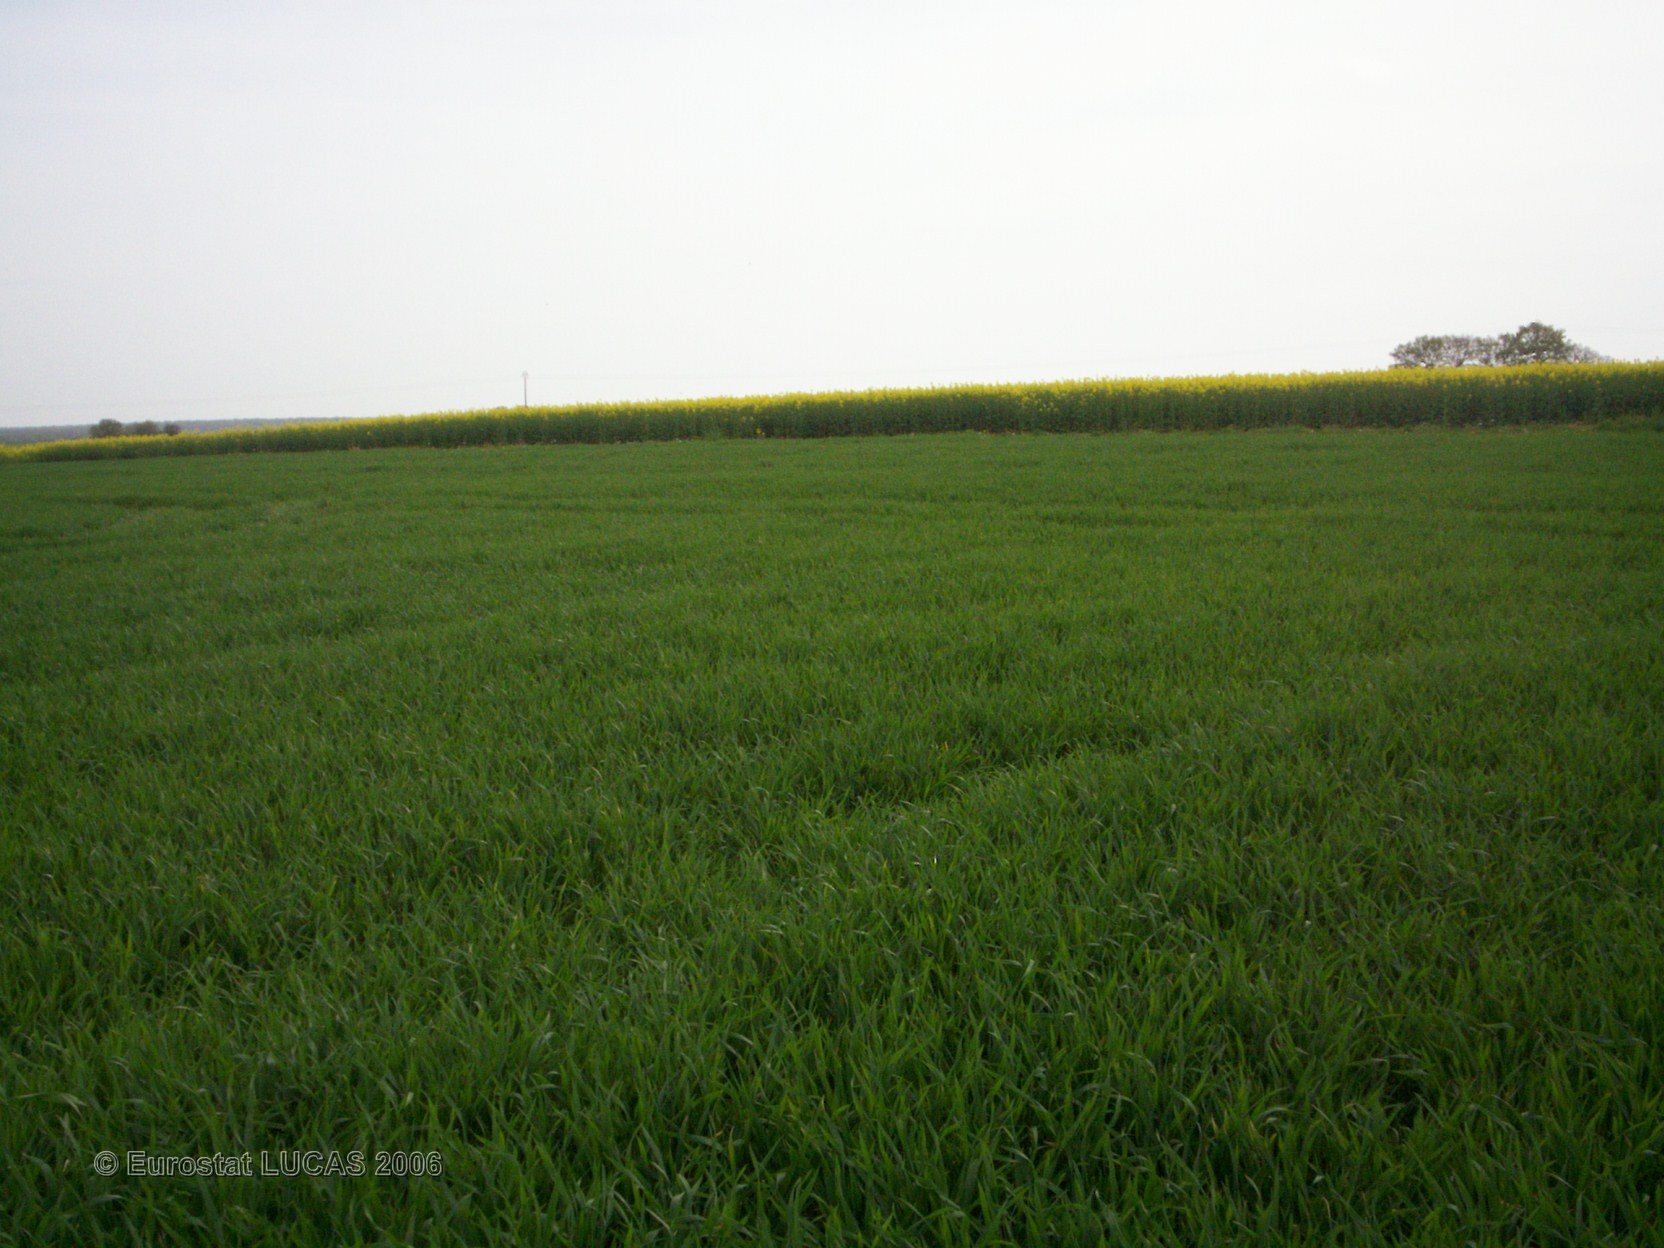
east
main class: Cropland
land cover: Common wheat
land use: Agriculture (excluding fallow land and kitchen gardens)
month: May
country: FR
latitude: 47.3194
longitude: 3.0758
